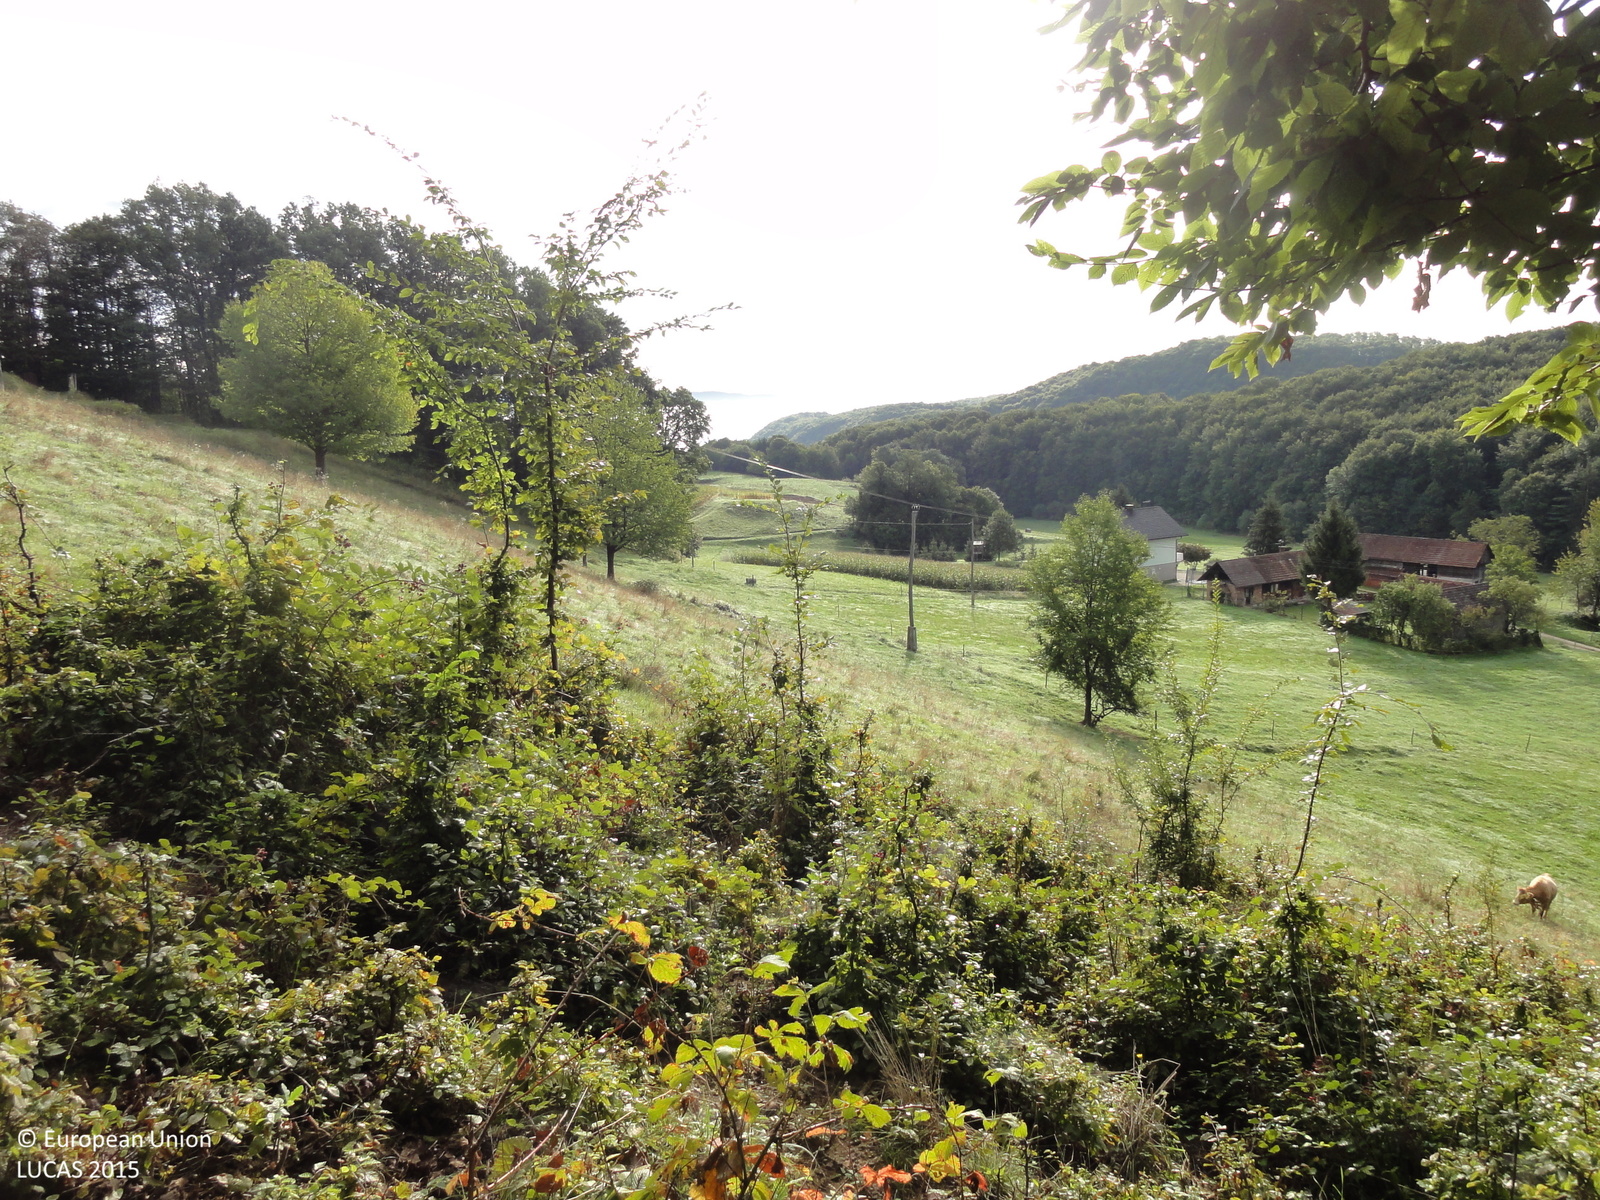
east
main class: Shrubland
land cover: Shrubland with sparse tree cover
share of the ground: 50 - 75 %
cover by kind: shrubs 45 %, herbaceous plants 30 %, broadleaved forest trees 5 %
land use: Agriculture (excluding fallow land and kitchen gardens)
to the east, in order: Shrubland with sparse tree cover; Grassland without tree/shrub cover; Grassland with sparse tree/shrub cover; Electric lines; Grassland with sparse tree/shrub cover; Electric lines; Grassland without tree/shrub cover; Fences; Grassland without tree/shrub cover; Tracks; Grassland with sparse tree/shrub cover; Ditches and canals; Grass margins; Paved roads, cycling and walking lanes; Grassland without tree/shrub cover; Tracks
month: September
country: SI
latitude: 45.8408
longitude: 15.6497
